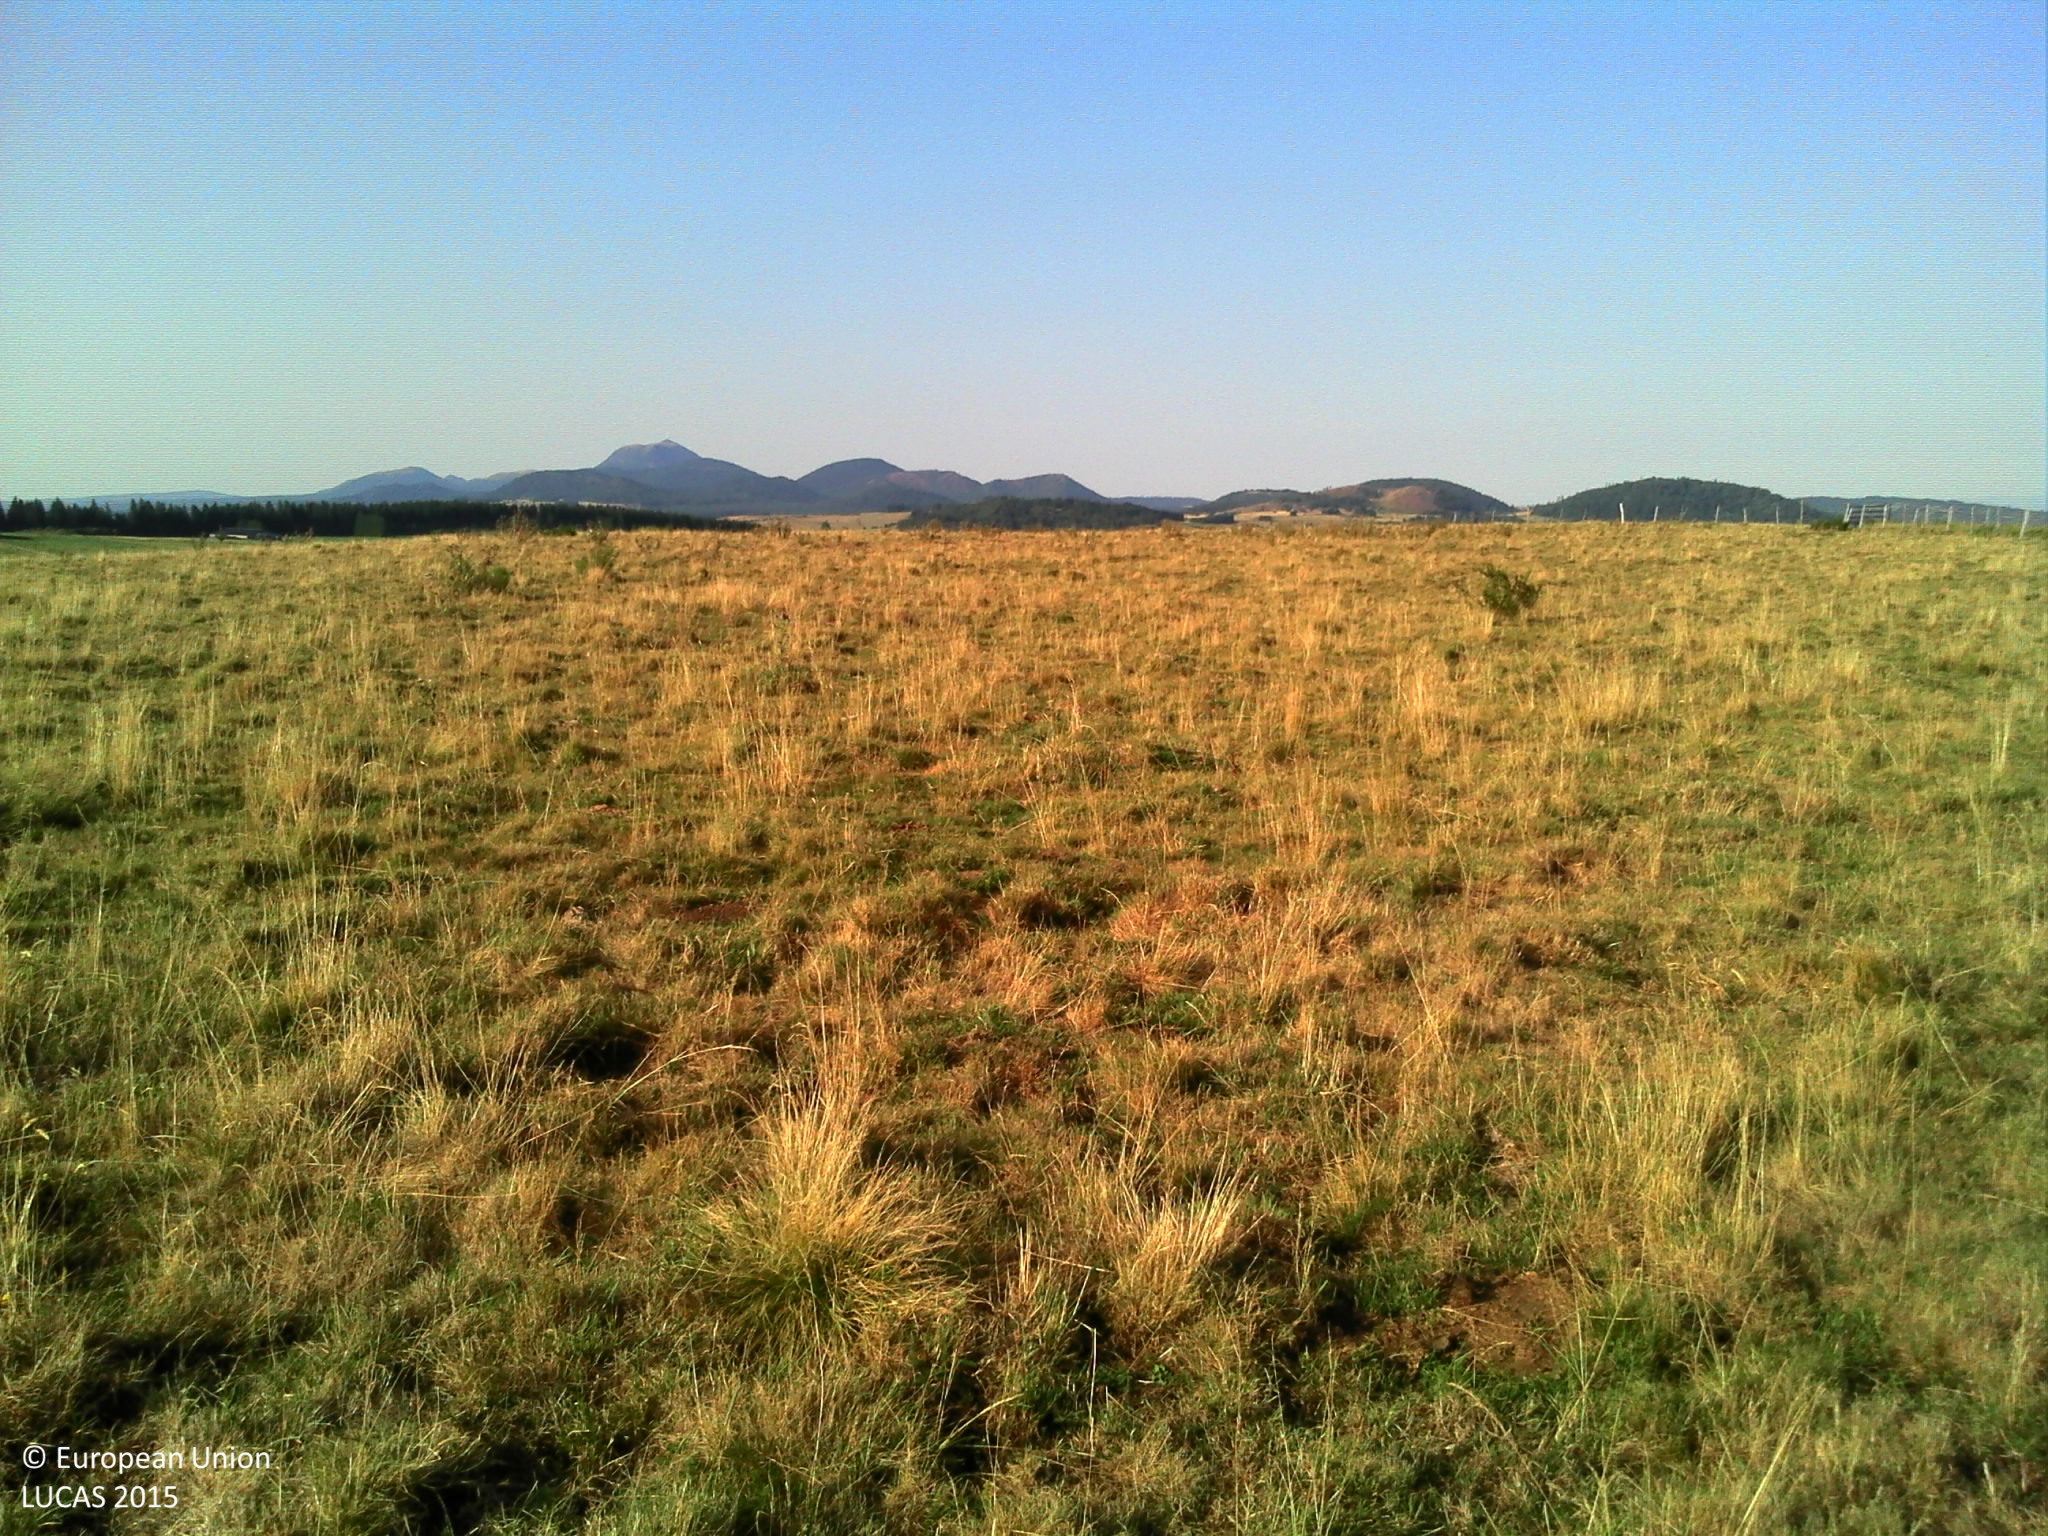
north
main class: Grassland
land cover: Grassland without tree/shrub cover
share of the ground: > 75 %
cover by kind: herbaceous plants 100 %
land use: Agriculture (excluding fallow land and kitchen gardens)
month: August
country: FR
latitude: 45.6274
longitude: 2.9065
